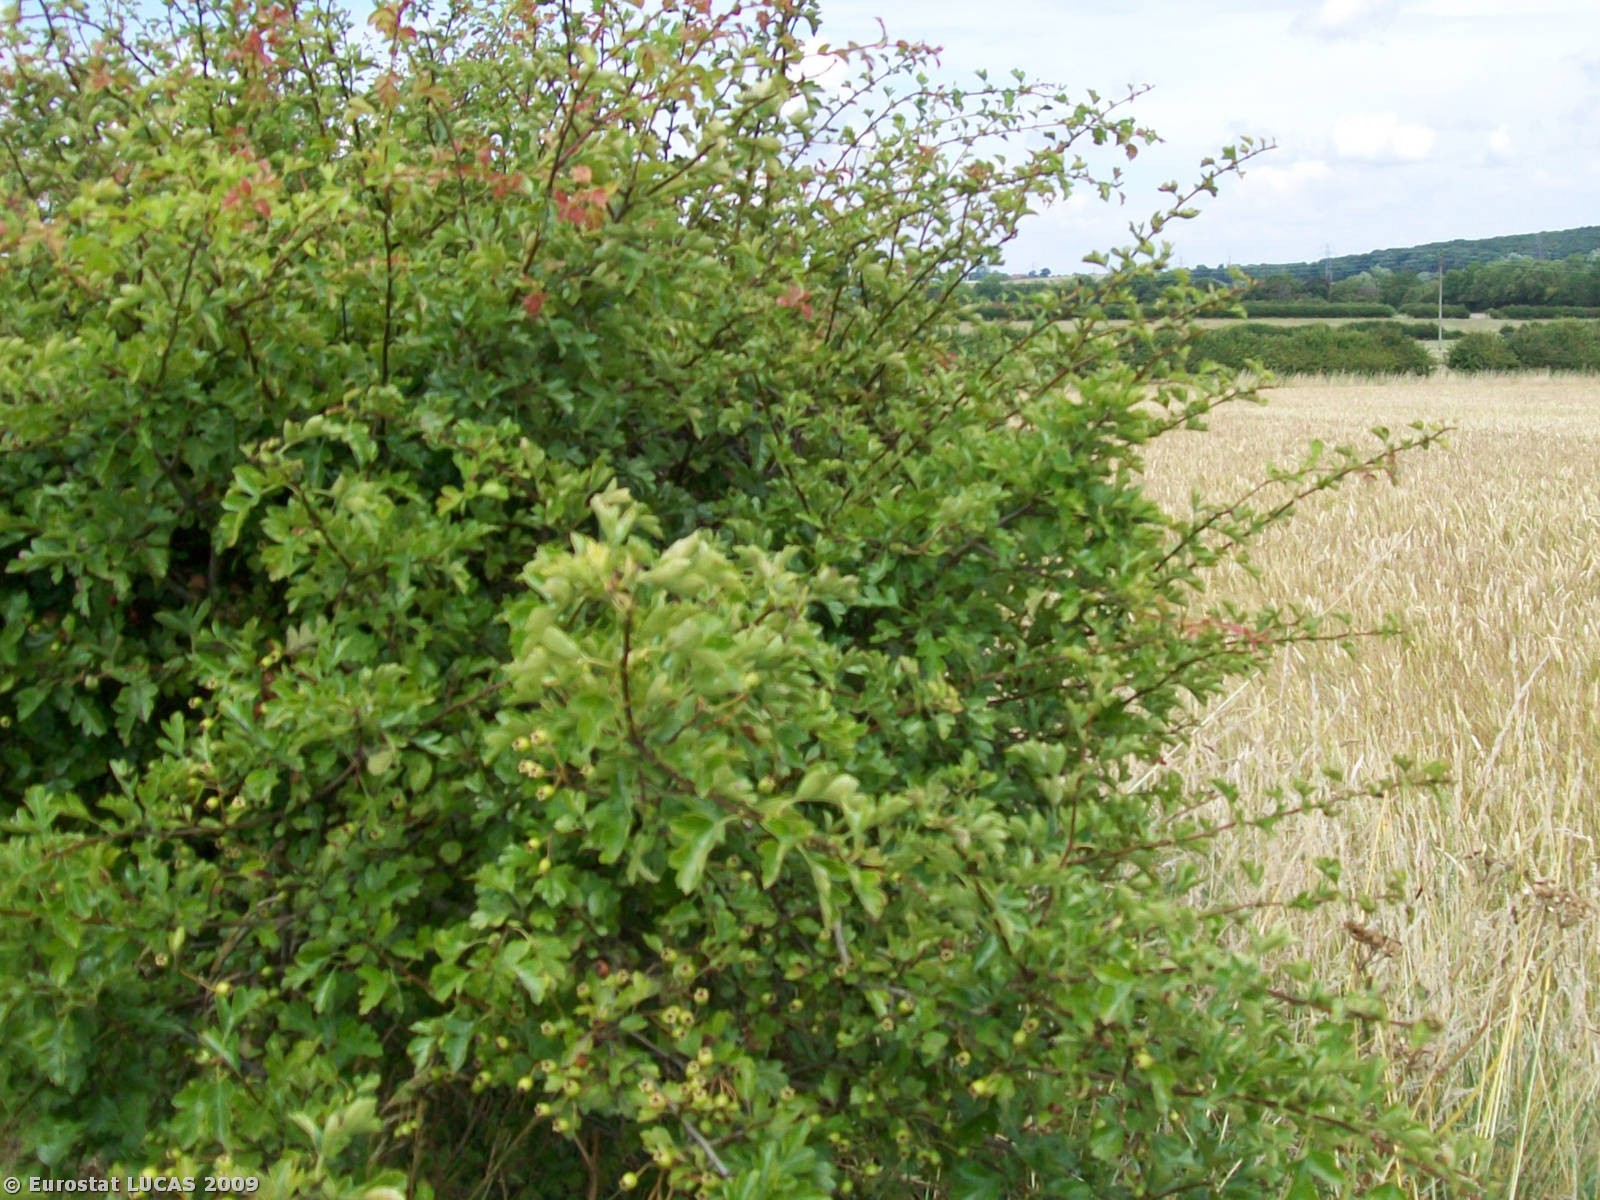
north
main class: Grassland
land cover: Grassland without tree/shrub cover
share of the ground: > 75 %
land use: Agriculture (excluding fallow land and kitchen gardens)
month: July
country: GB
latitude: 53.0873
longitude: -0.9274
